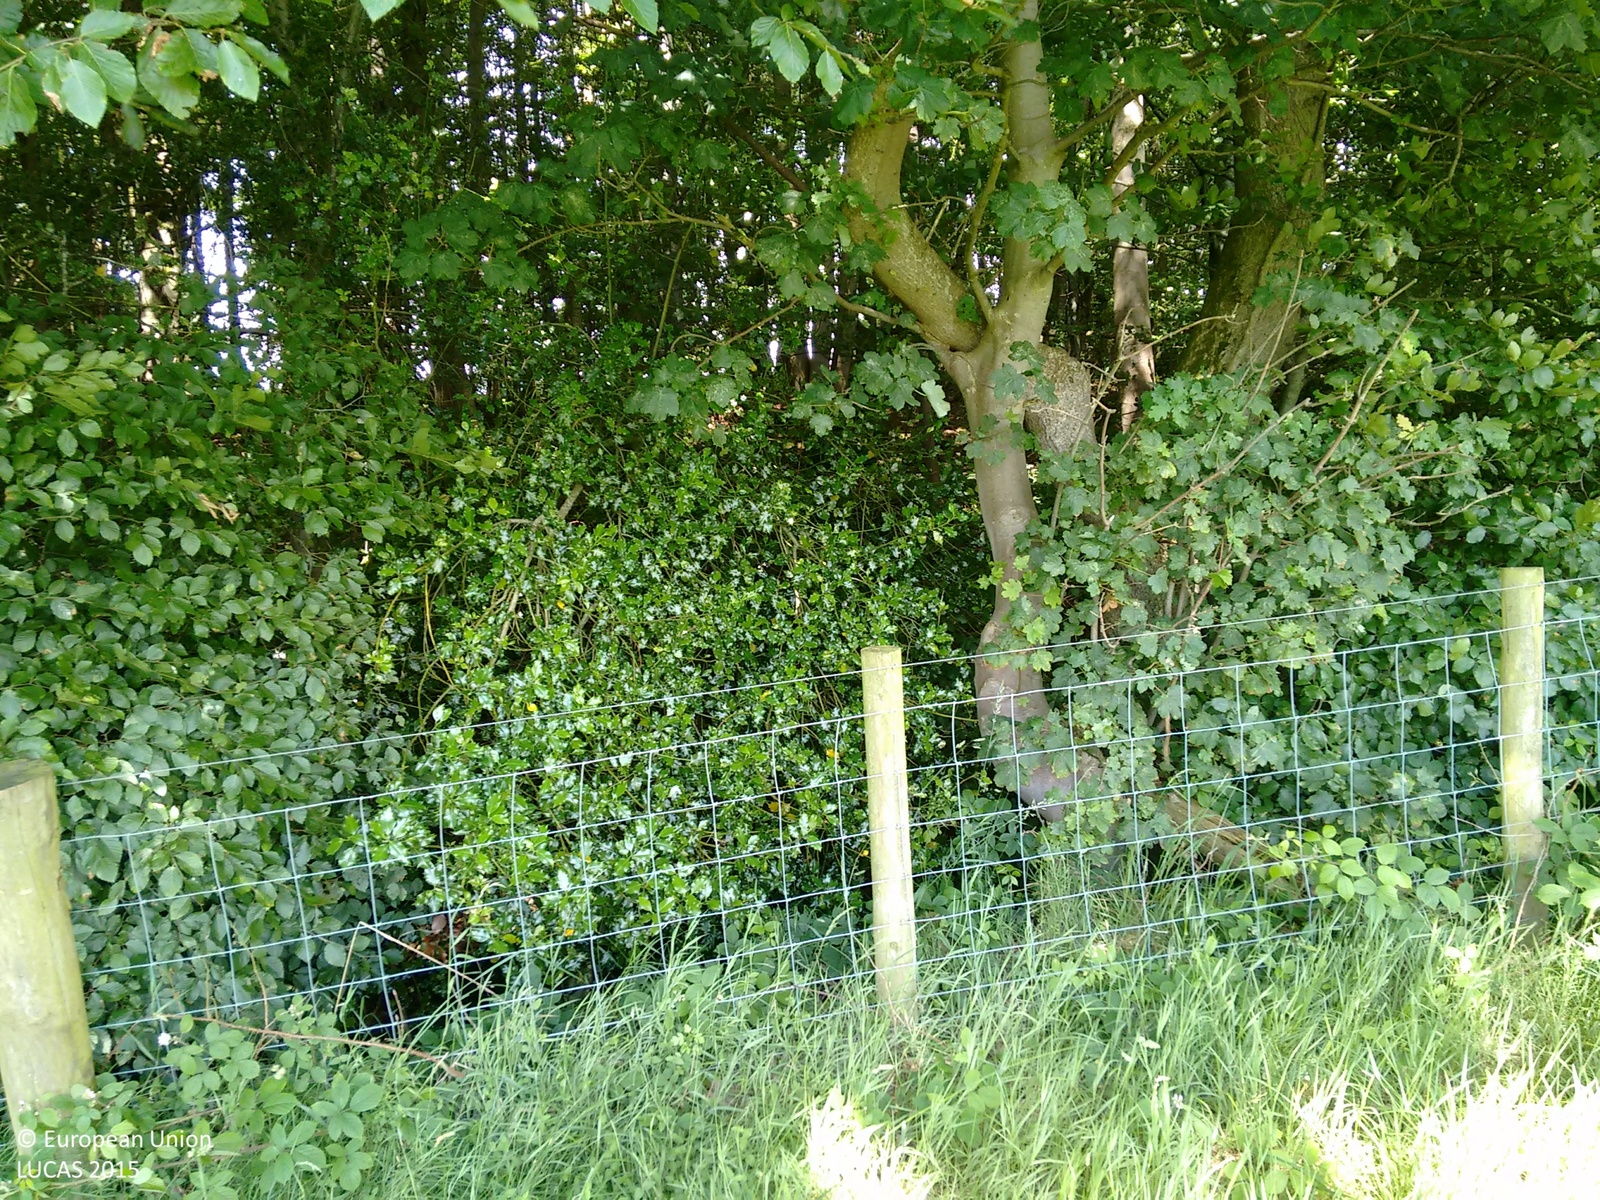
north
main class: Grassland
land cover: Grassland without tree/shrub cover
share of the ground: > 75 %
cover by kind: herbaceous plants 100 %
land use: Agriculture (excluding fallow land and kitchen gardens)
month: July
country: GB
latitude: 55.0034
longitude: -3.2556
